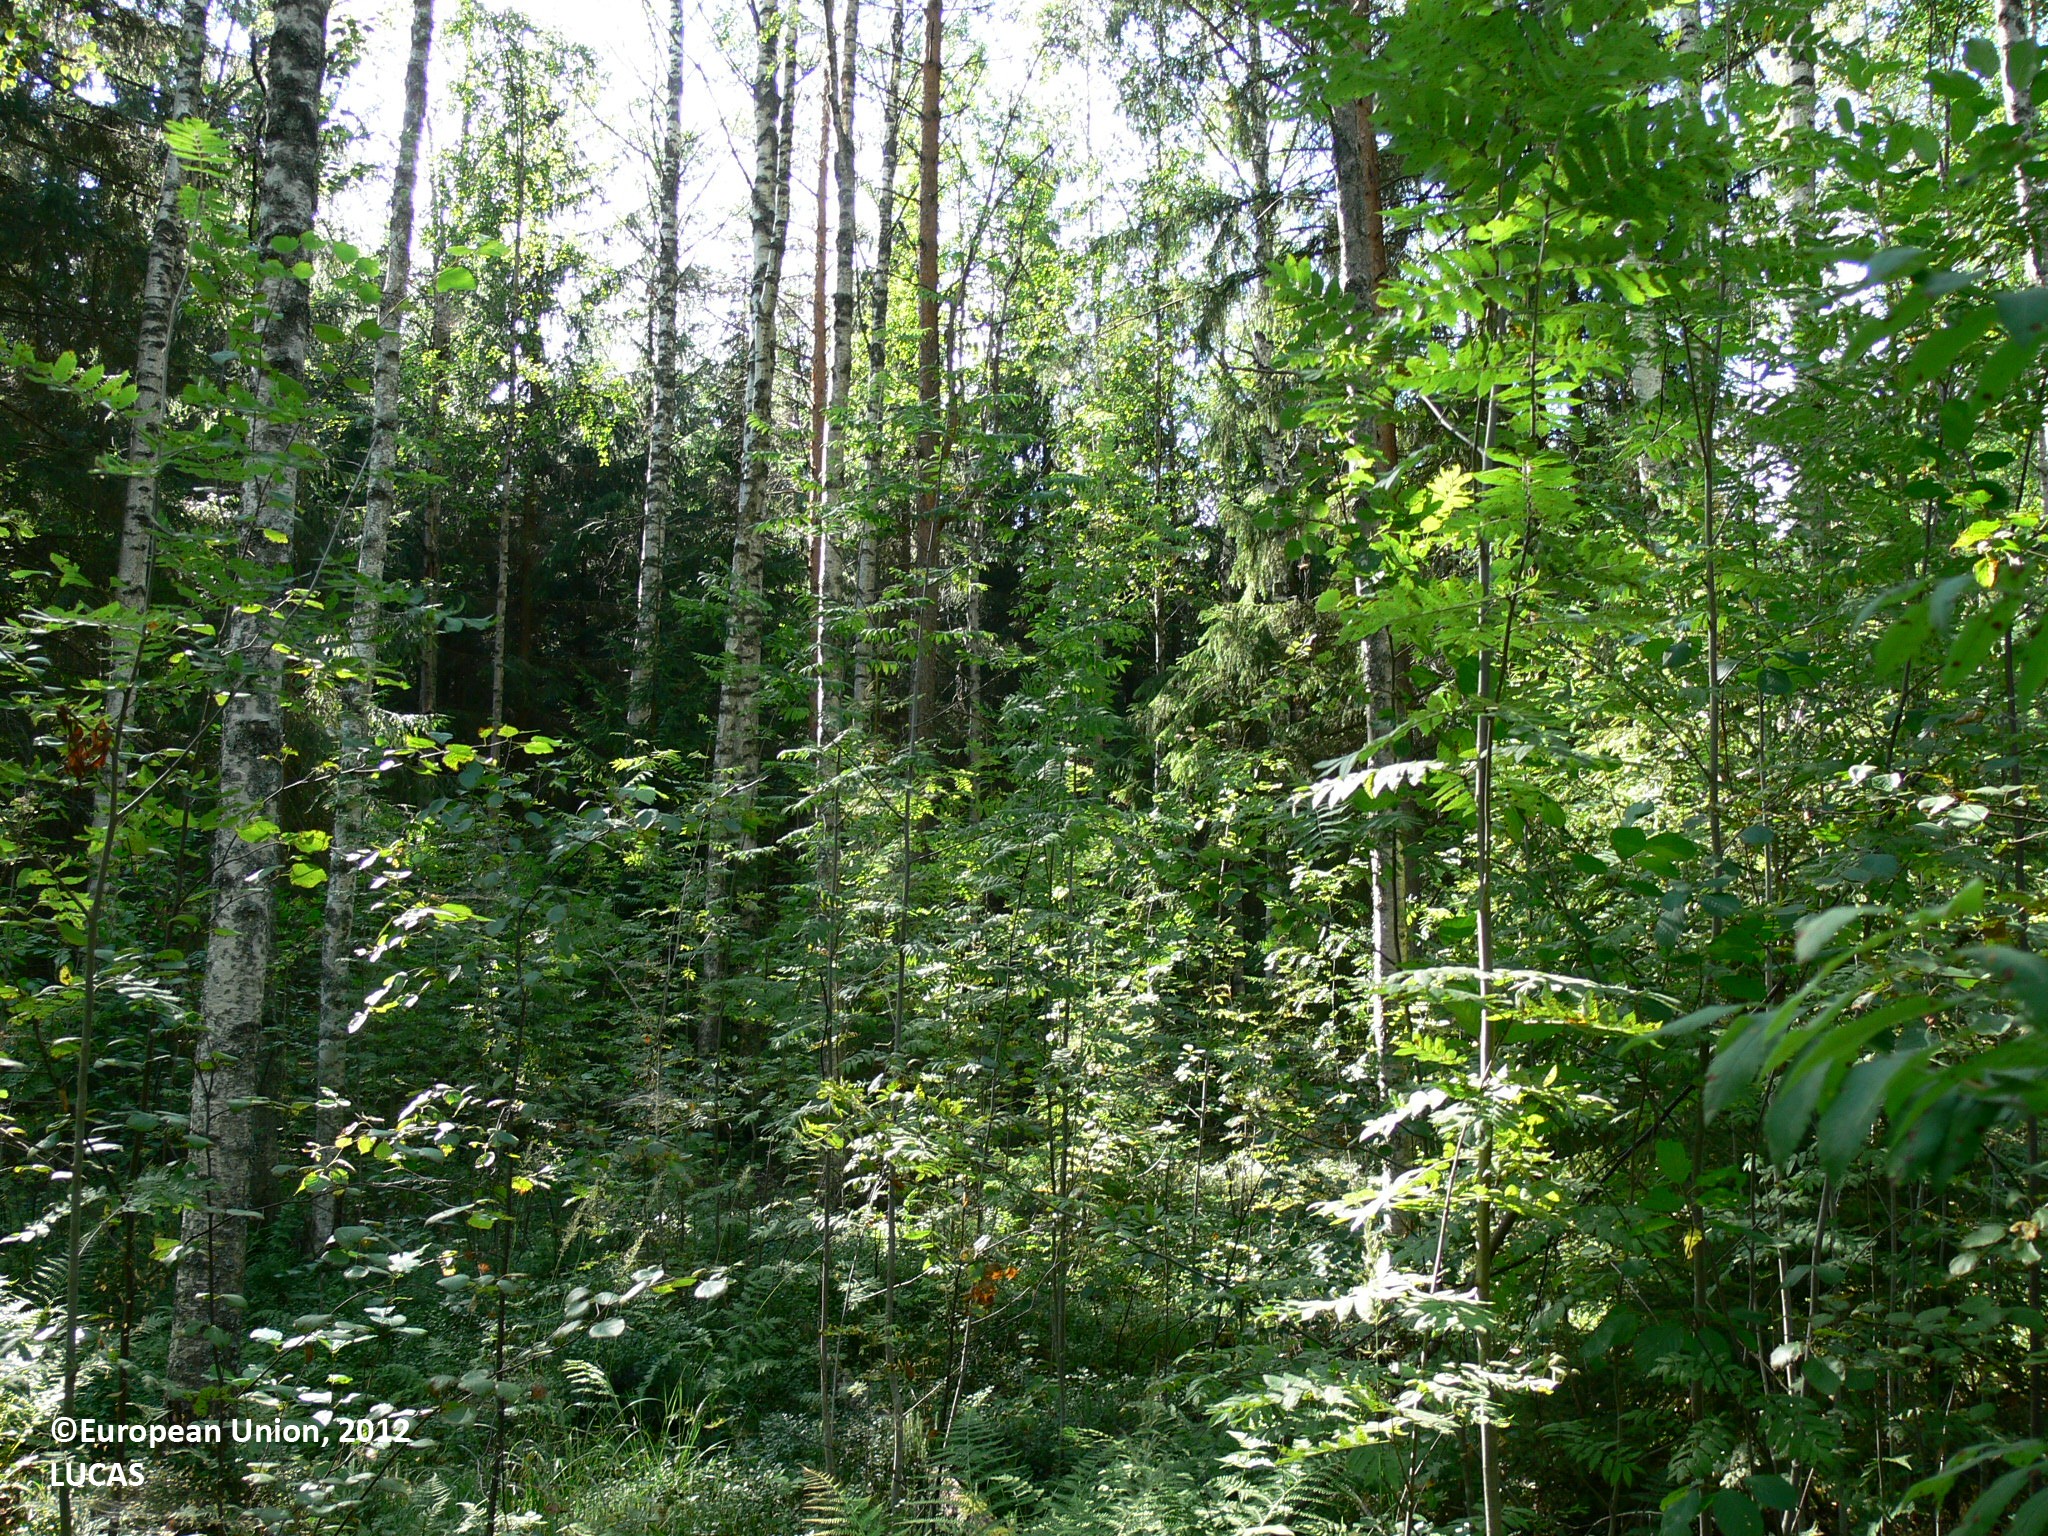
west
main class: Woodland
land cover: Other mixed woodland
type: boreal forest
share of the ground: > 75 %
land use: Forestry
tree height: > 5 m
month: August
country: FI
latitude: 61.8058
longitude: 29.1891
